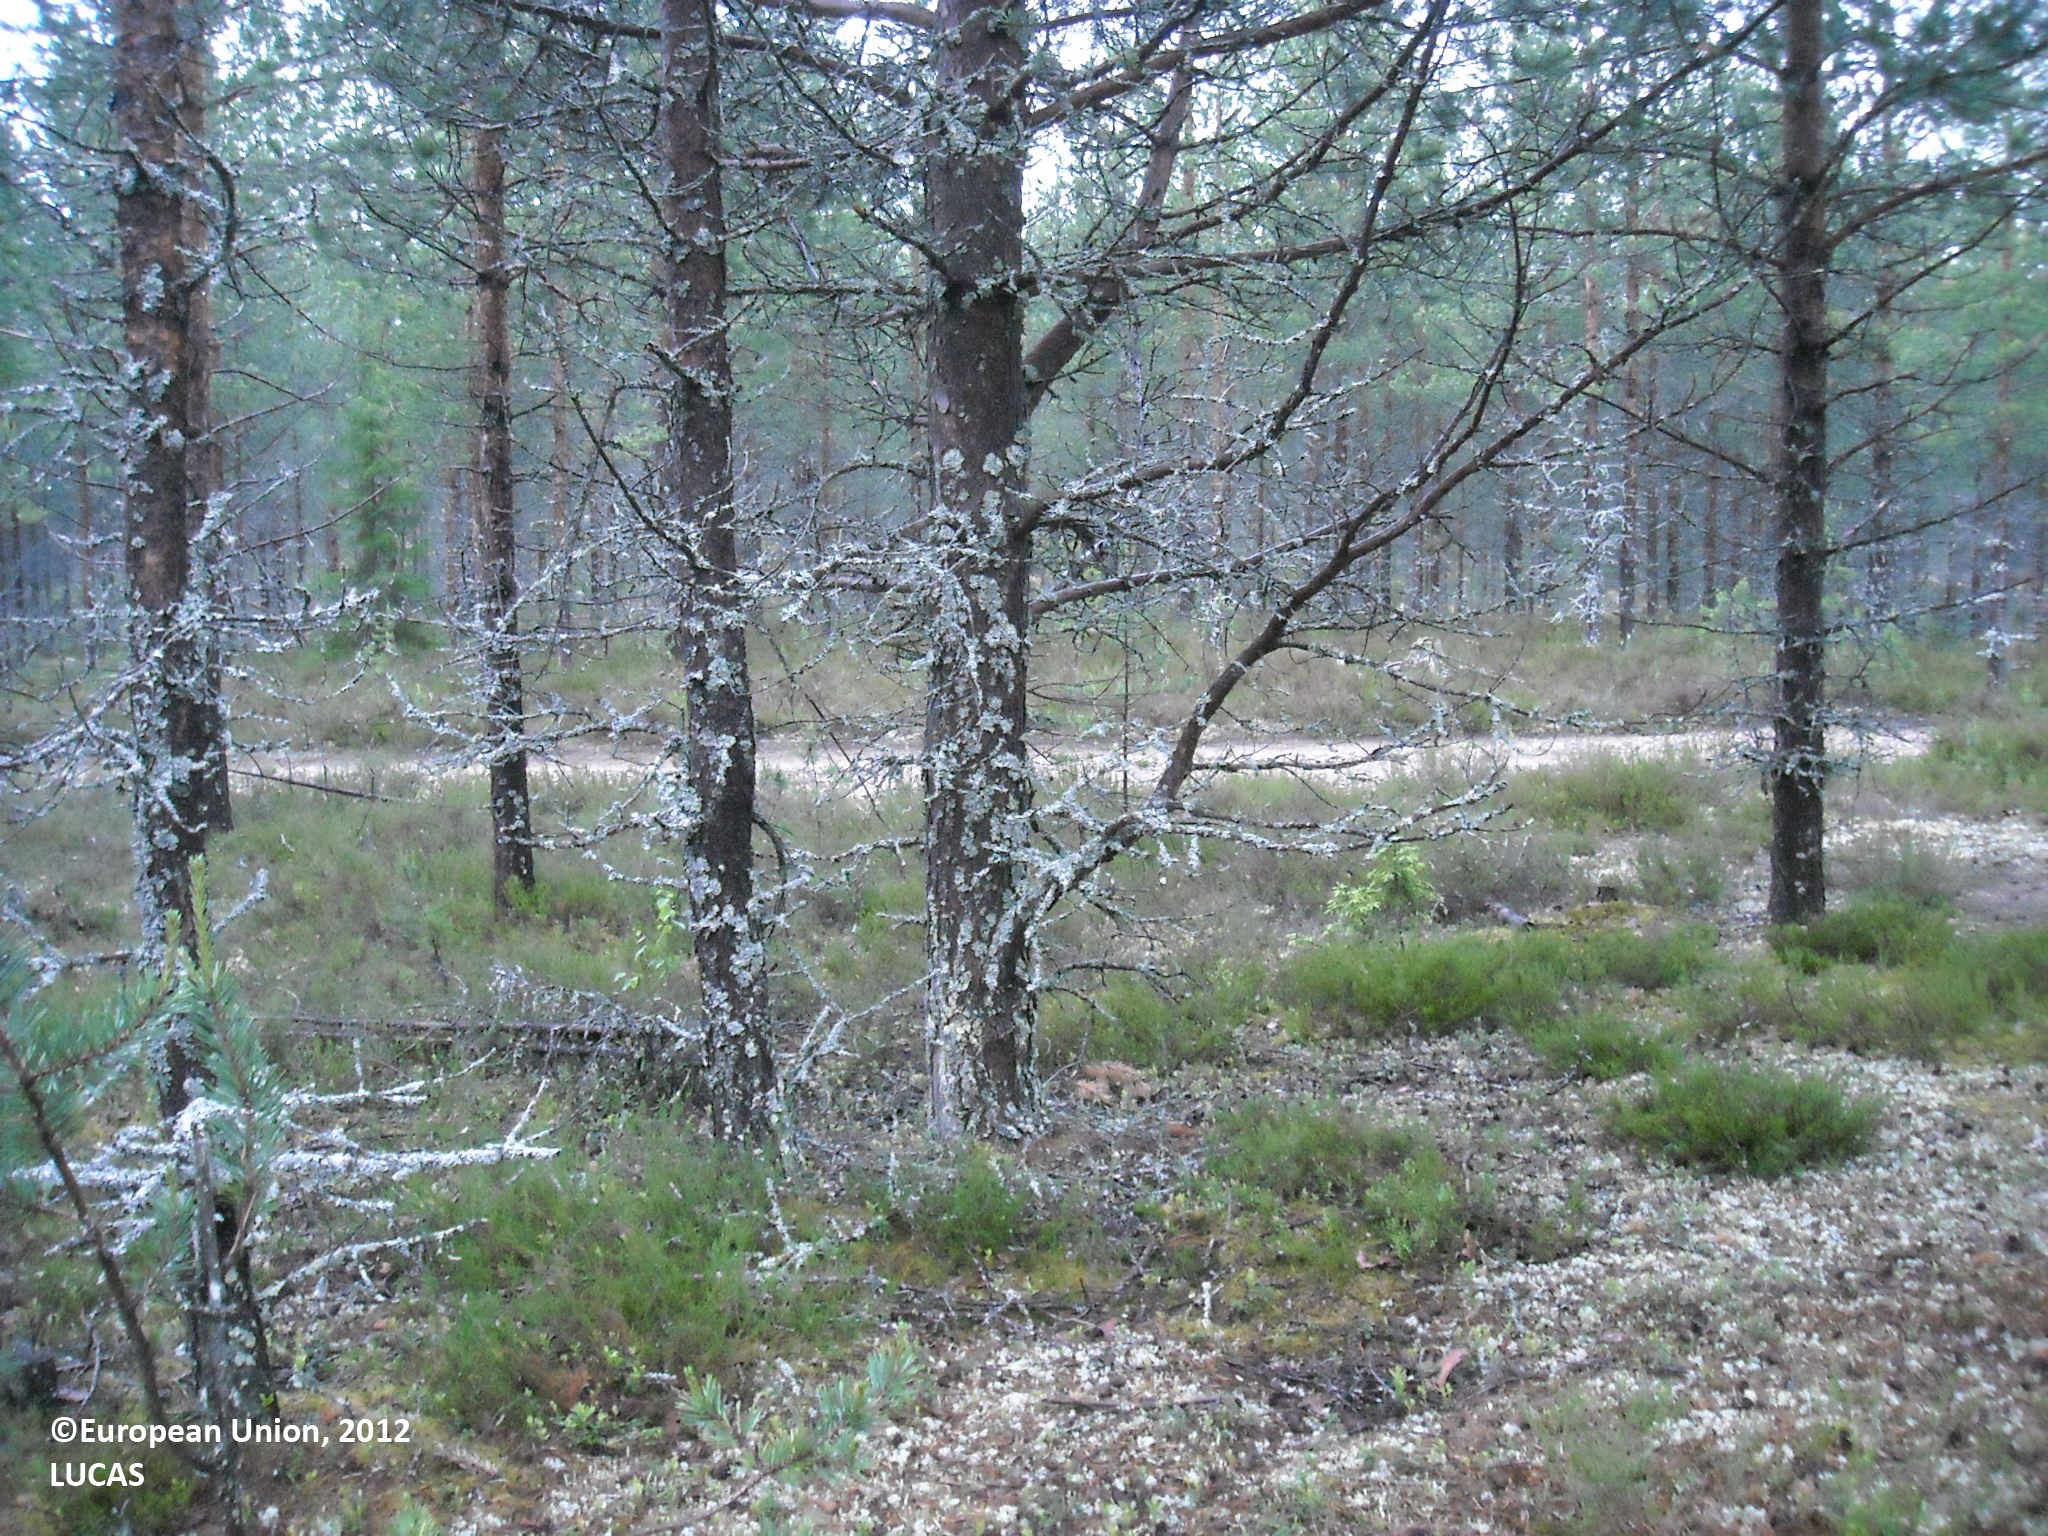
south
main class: Woodland
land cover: Pine dominated coniferous woodland
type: boreal forest
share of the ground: 25 - 50 %
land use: Forestry
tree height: > 5 m
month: July
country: FI
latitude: 64.9883
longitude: 28.0662
